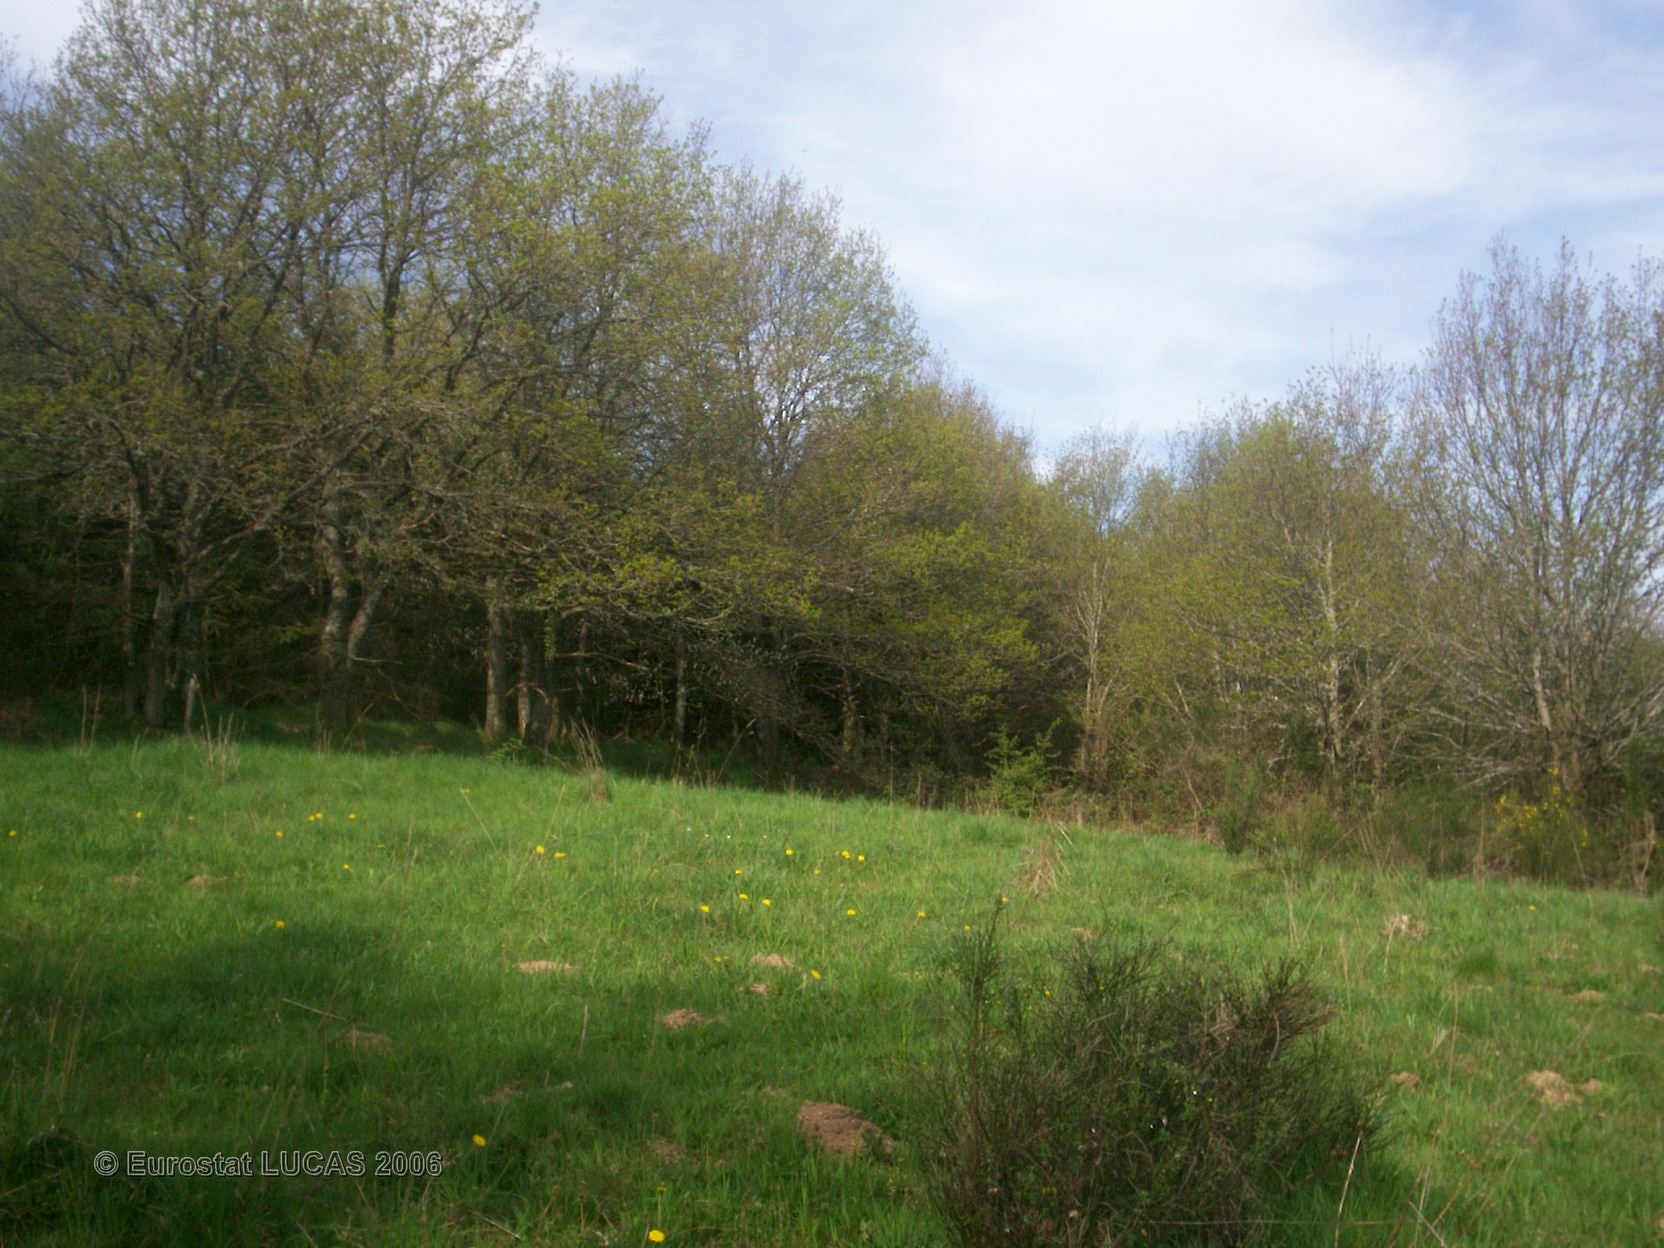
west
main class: Grassland
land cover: Grassland without tree/shrub cover
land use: Agriculture (excluding fallow land and kitchen gardens)
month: May
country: FR
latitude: 45.9714
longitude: 2.9132
